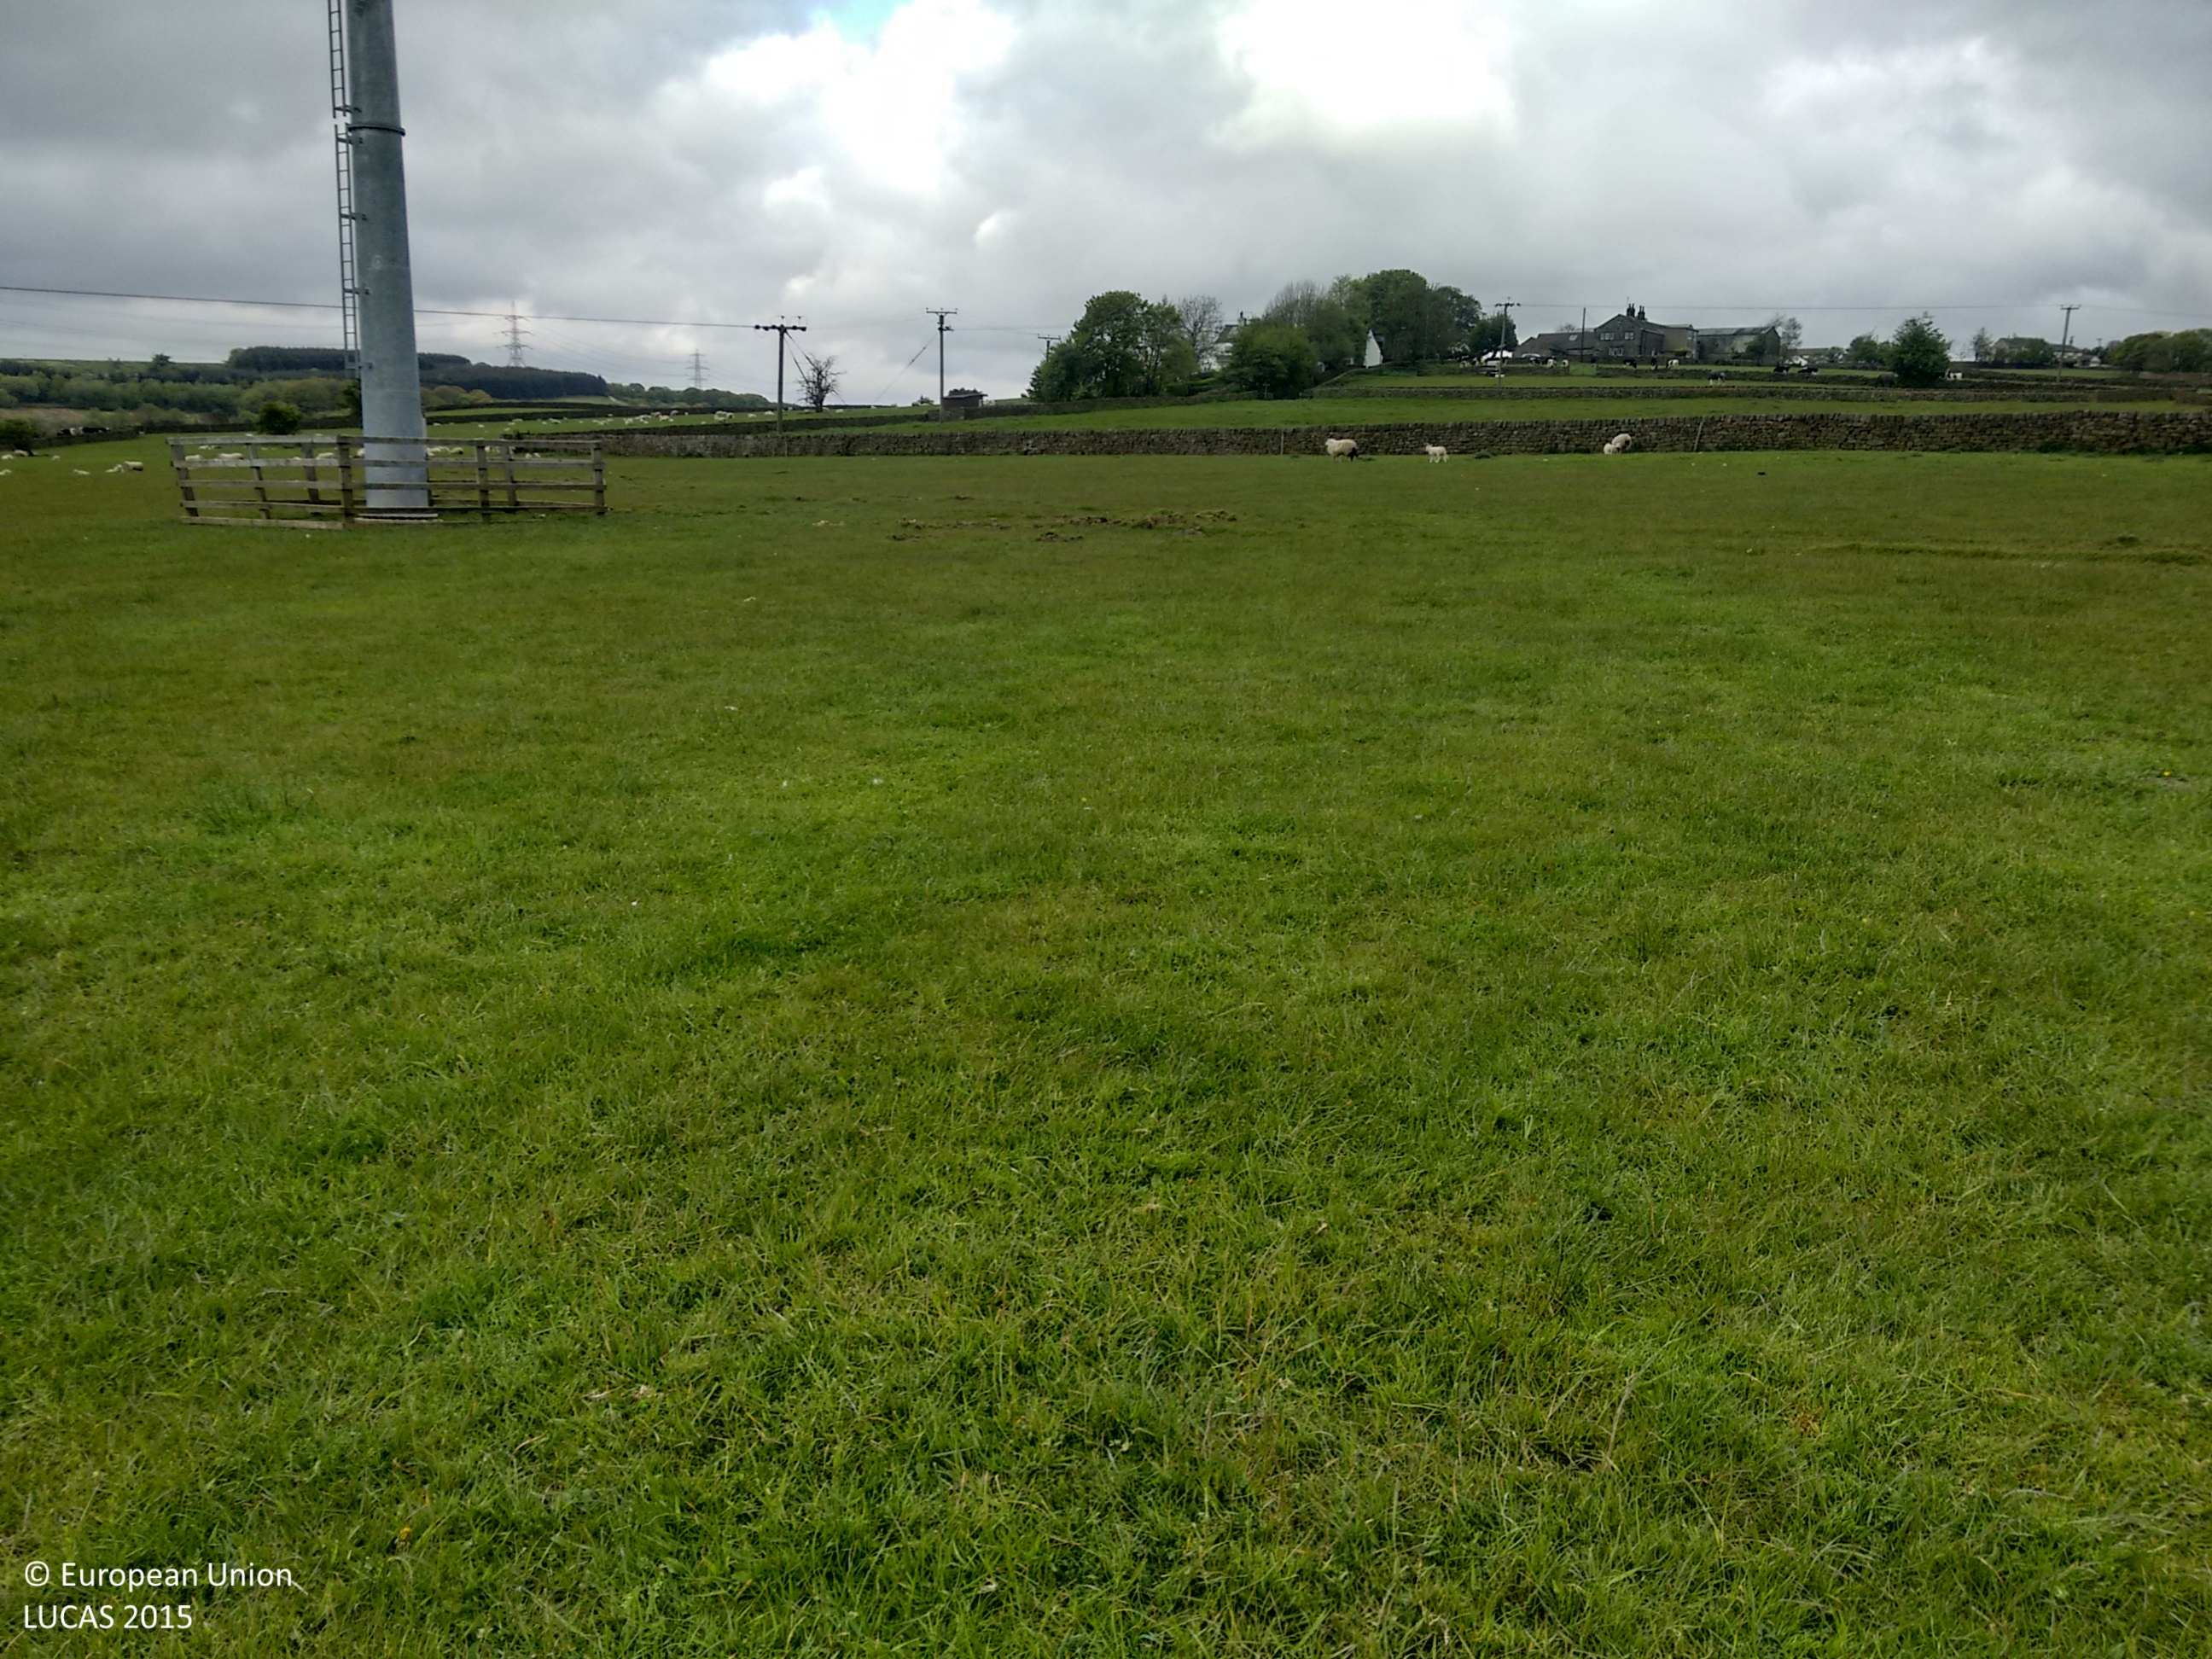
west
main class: Grassland
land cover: Grassland without tree/shrub cover
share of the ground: > 75 %
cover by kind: herbaceous plants 100 %
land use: Agriculture (excluding fallow land and kitchen gardens)
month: May
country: GB
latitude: 53.5248
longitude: -1.6826
